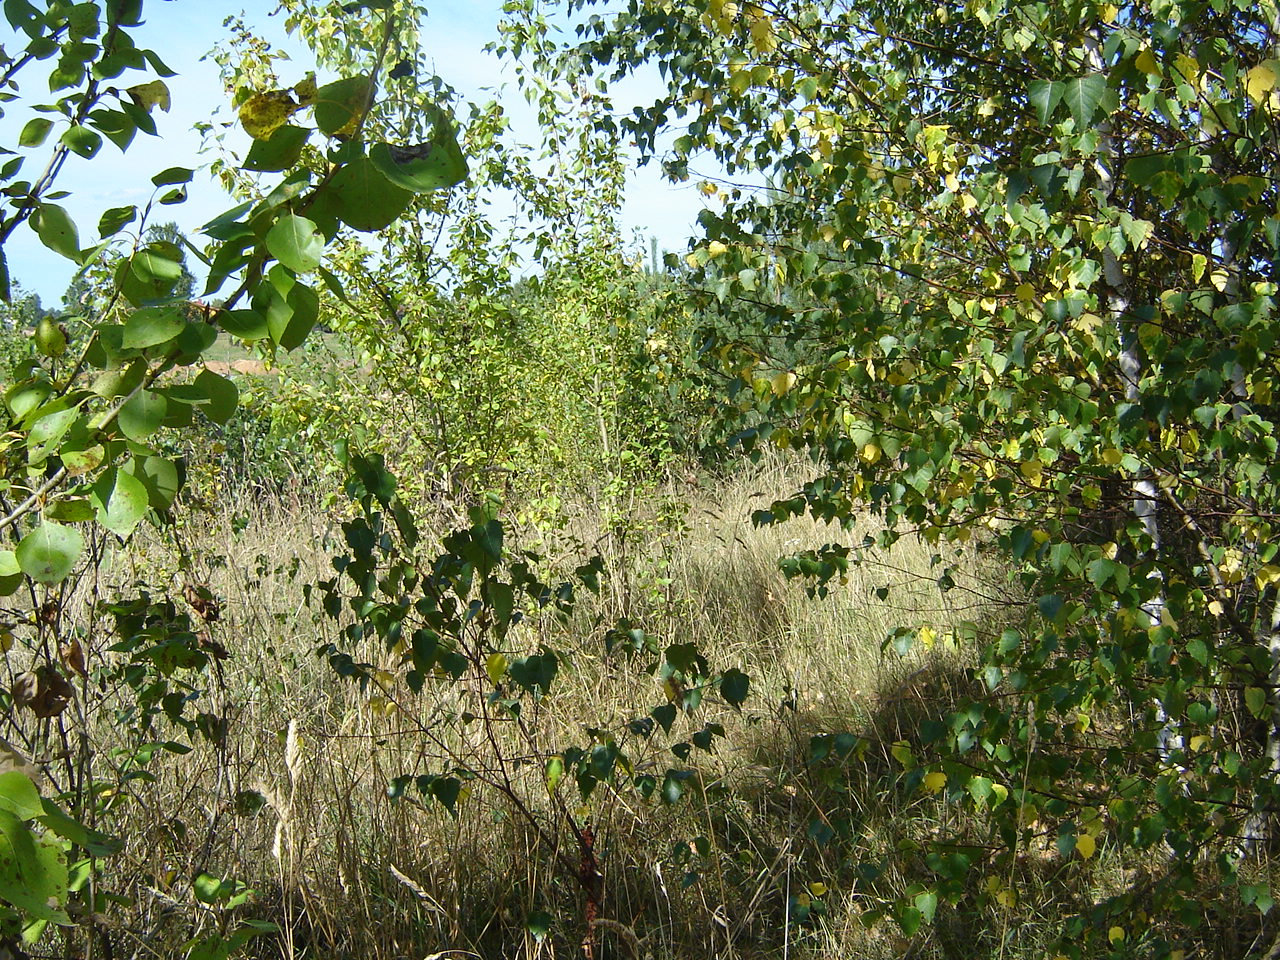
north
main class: Woodland
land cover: Broadleaved woodland
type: non-riverine alder, birch or aspen forest
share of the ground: 50 - 75 %
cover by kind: broadleaved forest trees 65 %, herbaceous plants 30 %, coniferous forest trees 5 %
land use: Forestry
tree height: > 5 m
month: August
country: LT
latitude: 54.7113
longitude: 25.1586
